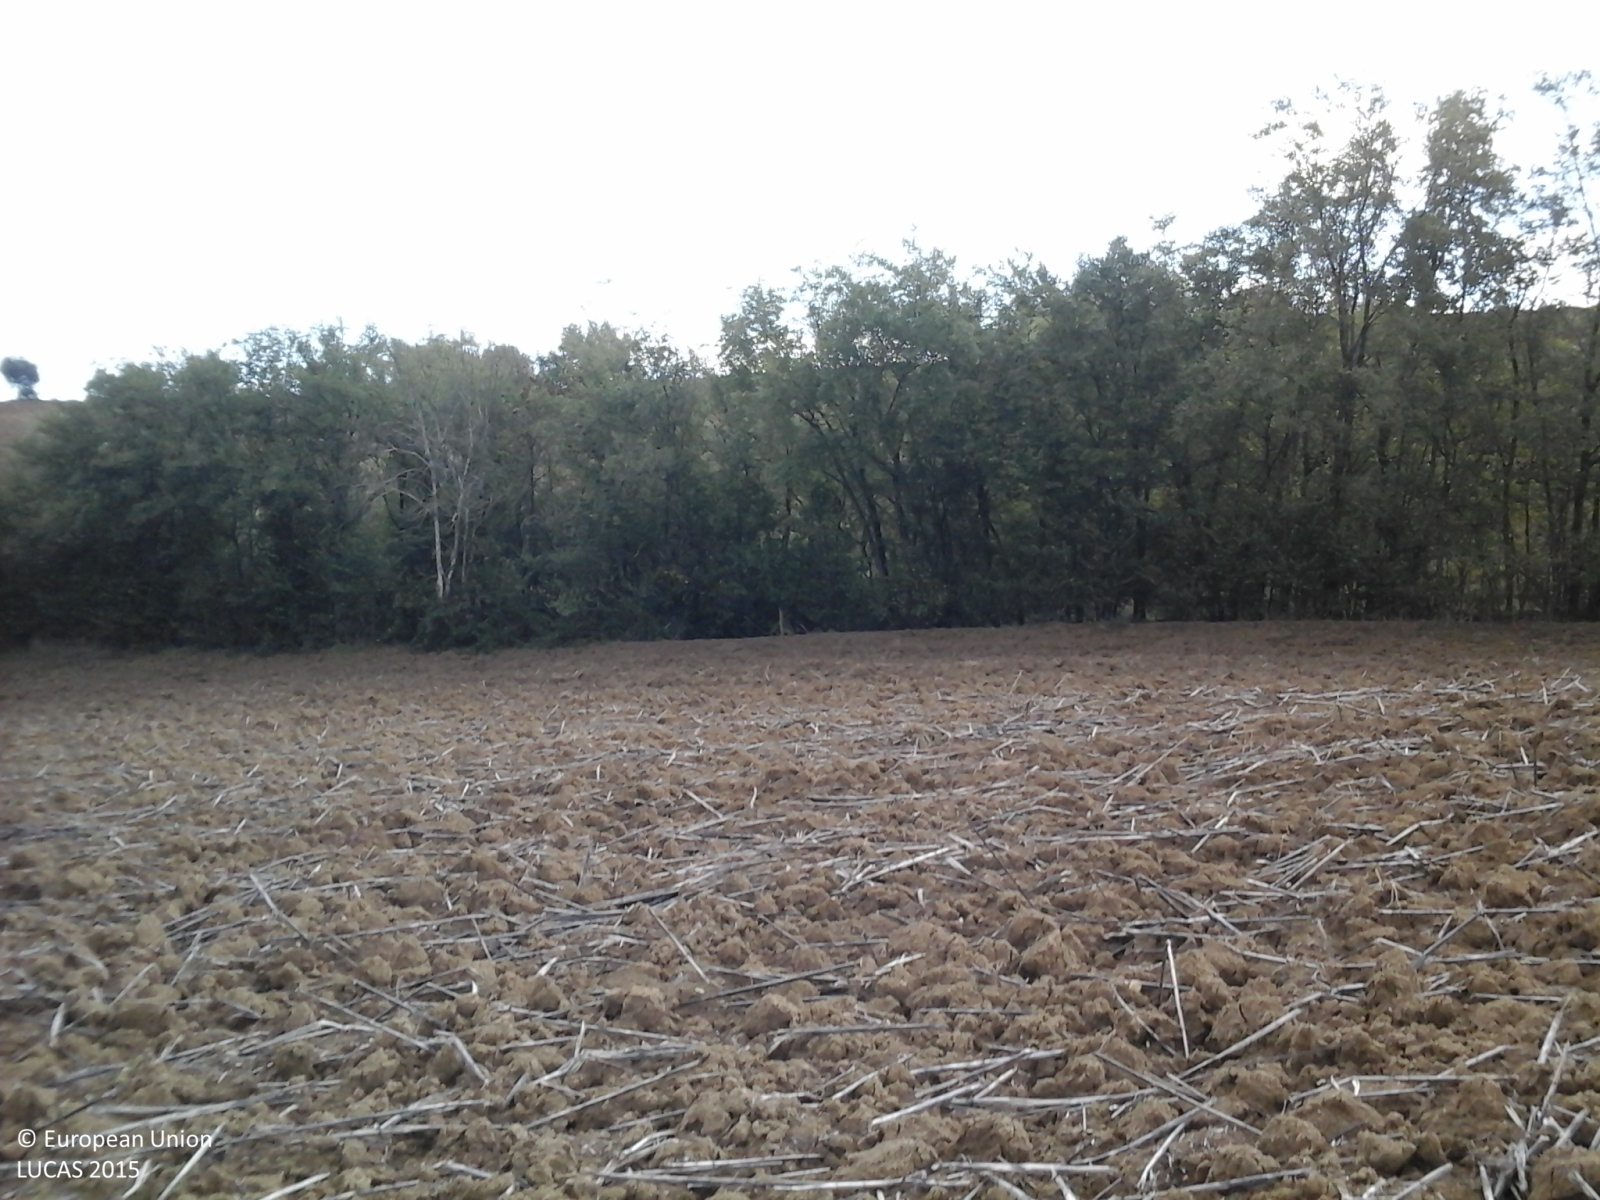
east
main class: Cropland
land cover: Sunflower
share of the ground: < 10 %
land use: Agriculture (excluding fallow land and kitchen gardens)
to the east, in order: Sunflower; Broadleaved woodland; Ditches and canals; Broadleaved woodland; Other bare soil; Ditches and canals; Grass margins; Tracks; Grass margins; Durum wheat; Electric lines; Durum wheat
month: October
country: IT
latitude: 43.5438
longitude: 13.1729
